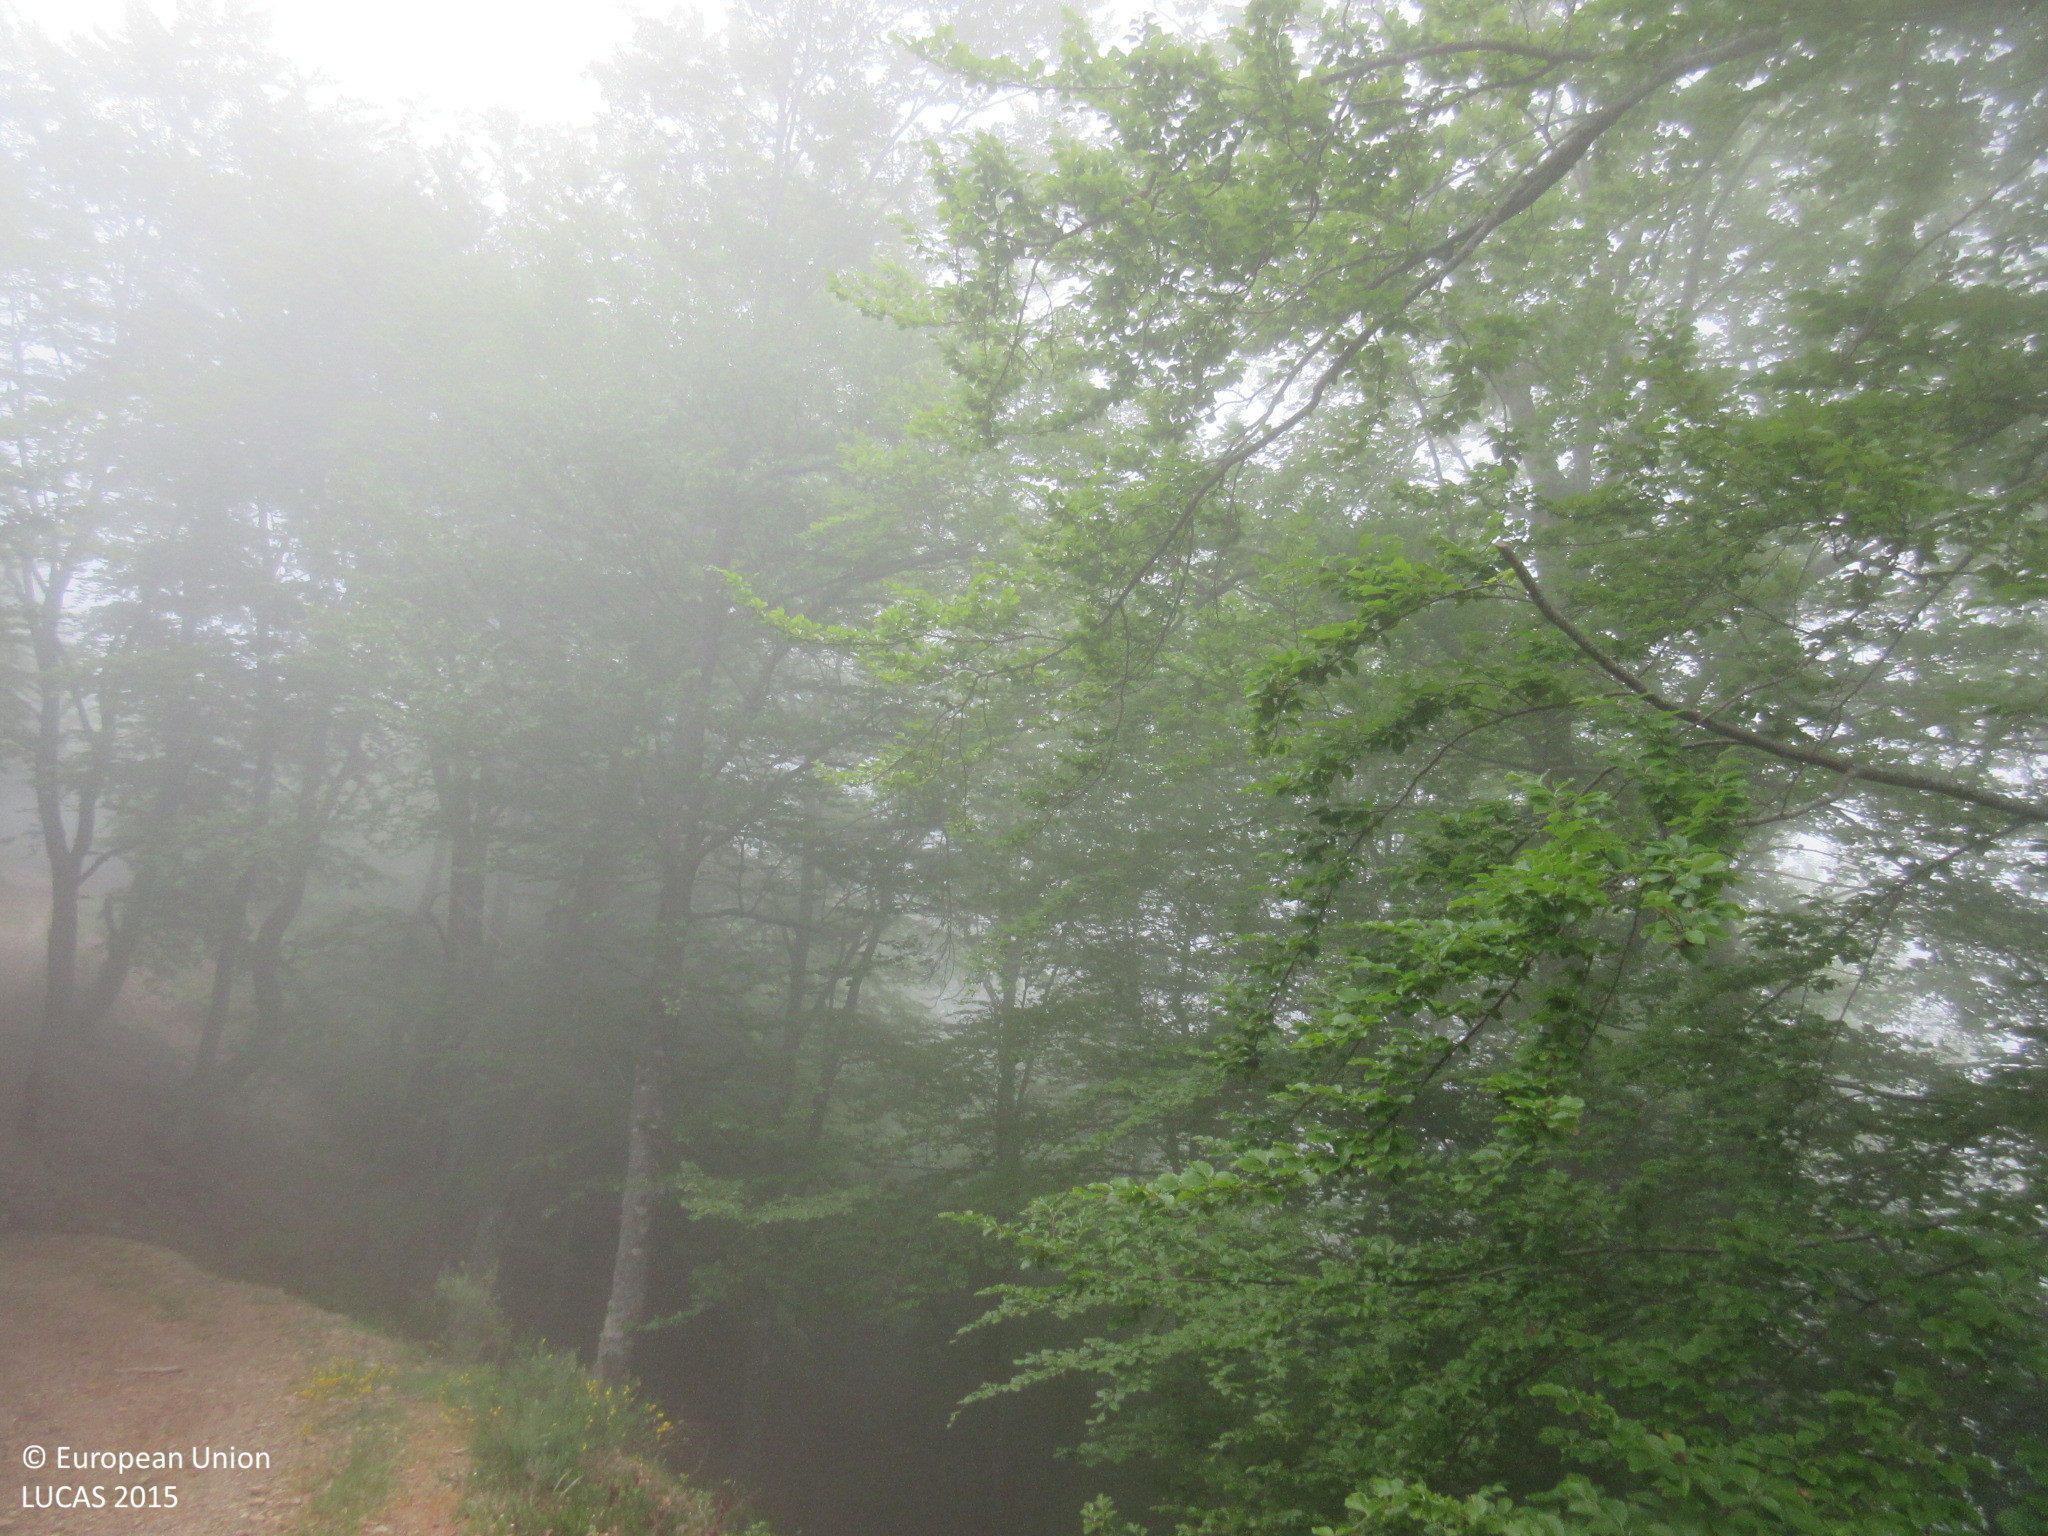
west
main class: Woodland
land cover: Broadleaved woodland
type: beech forest
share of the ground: > 75 %
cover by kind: broadleaved forest trees 95 %, shrubs 5 %
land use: Semi-natural and natural areas not in use
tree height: > 5 m
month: June
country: ES
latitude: 43.1597
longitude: -4.5092
